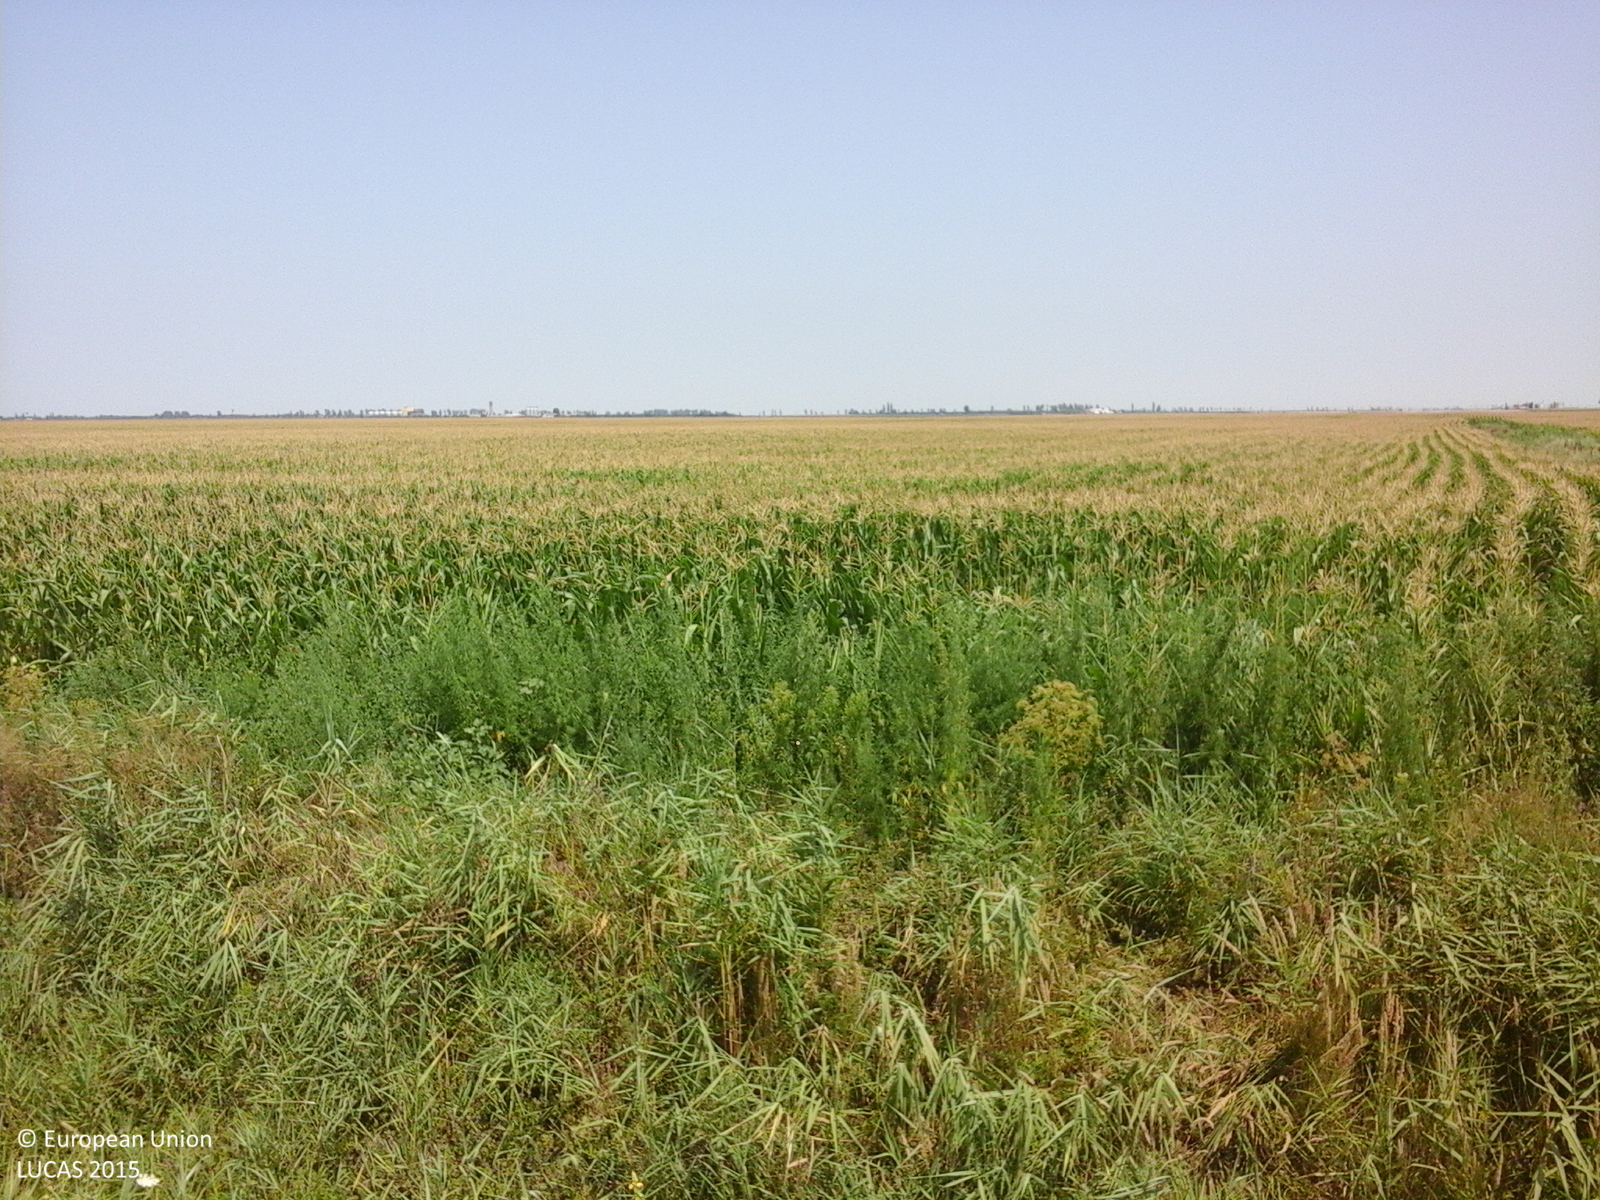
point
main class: Cropland
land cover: Maize
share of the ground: > 75 %
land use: Agriculture (excluding fallow land and kitchen gardens)
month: July
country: RO
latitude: 44.7818
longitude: 26.8478
